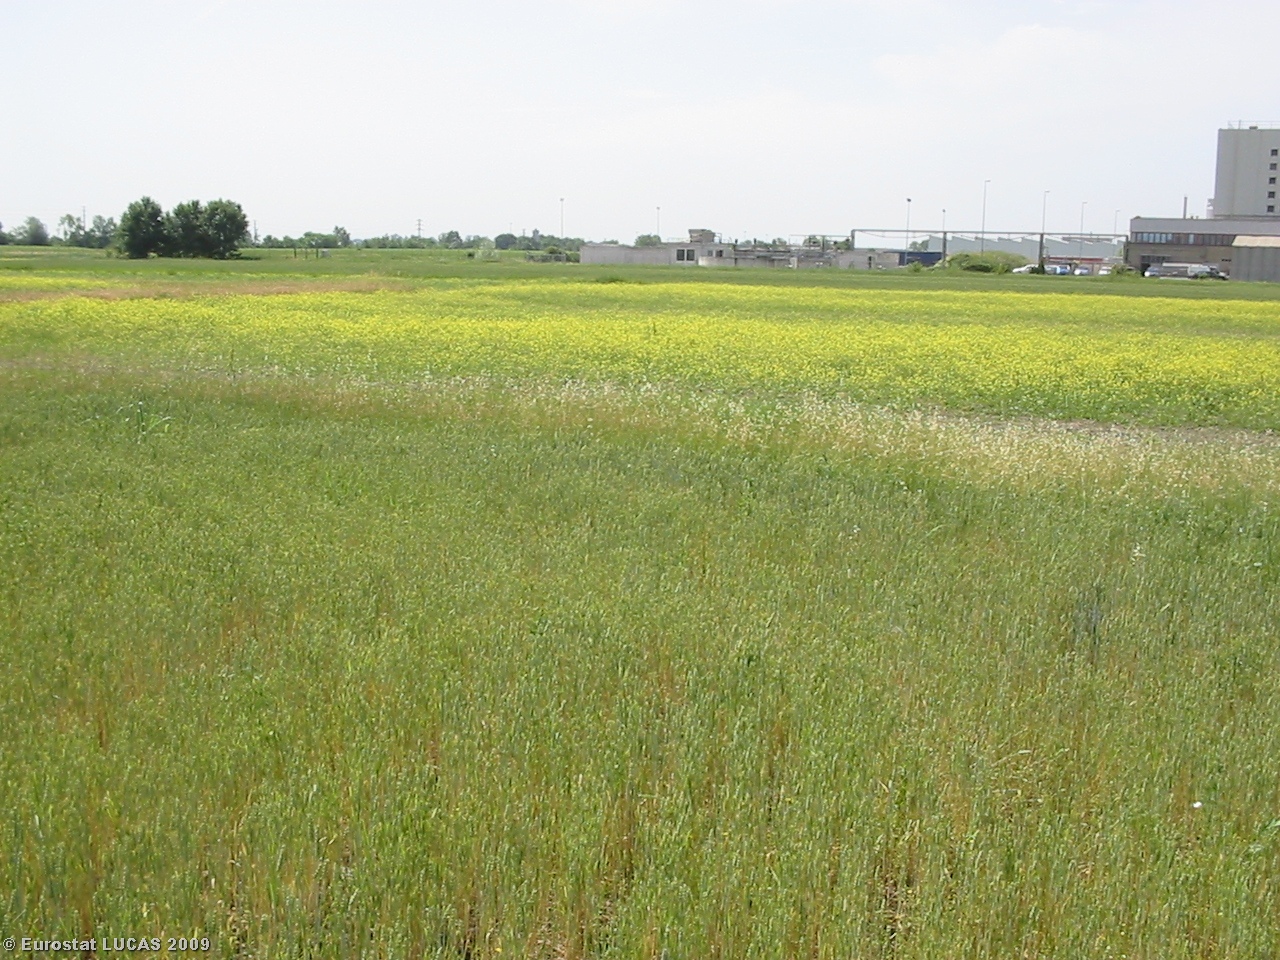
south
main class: Cropland
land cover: Common wheat
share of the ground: > 75 %
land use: Agriculture (excluding fallow land and kitchen gardens)
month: May
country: IT
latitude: 44.9089
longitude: 10.3666
